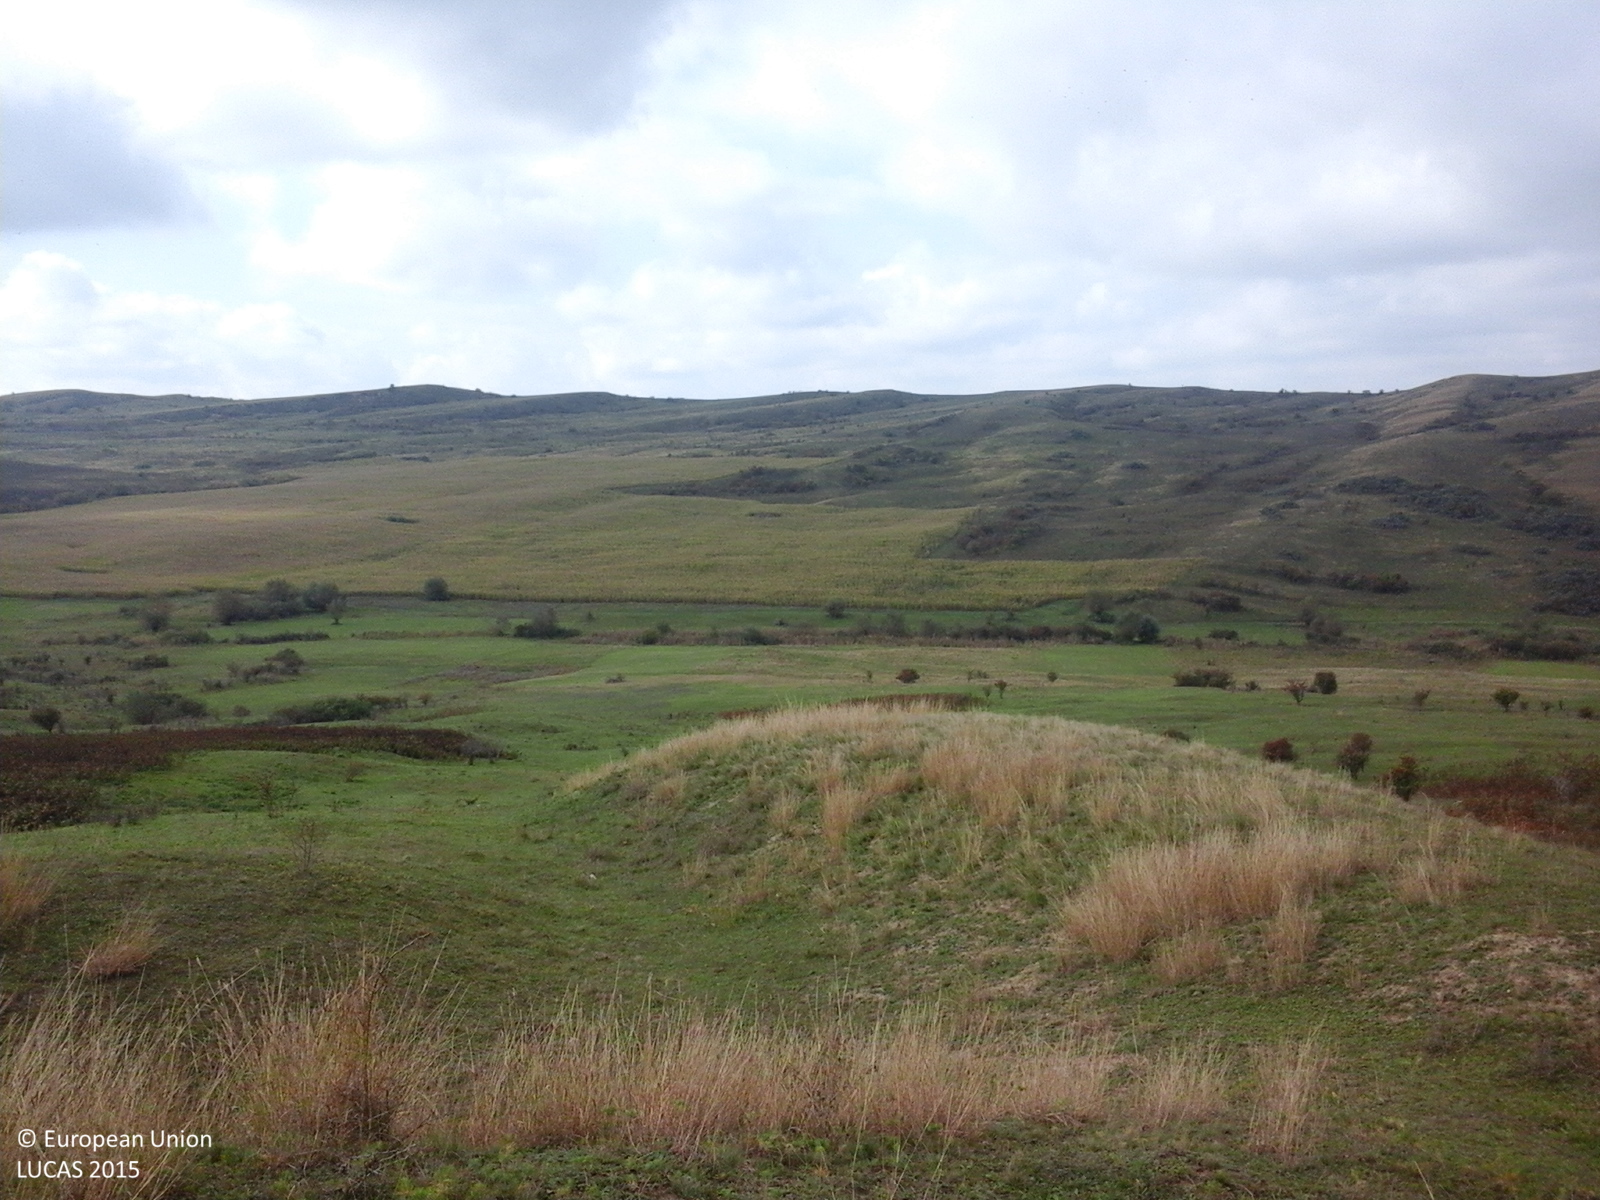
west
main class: Grassland
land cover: Grassland without tree/shrub cover
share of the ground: > 75 %
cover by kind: herbaceous plants 100 %
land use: Agriculture (excluding fallow land and kitchen gardens)
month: October
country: RO
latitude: 46.4245
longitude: 24.0393
